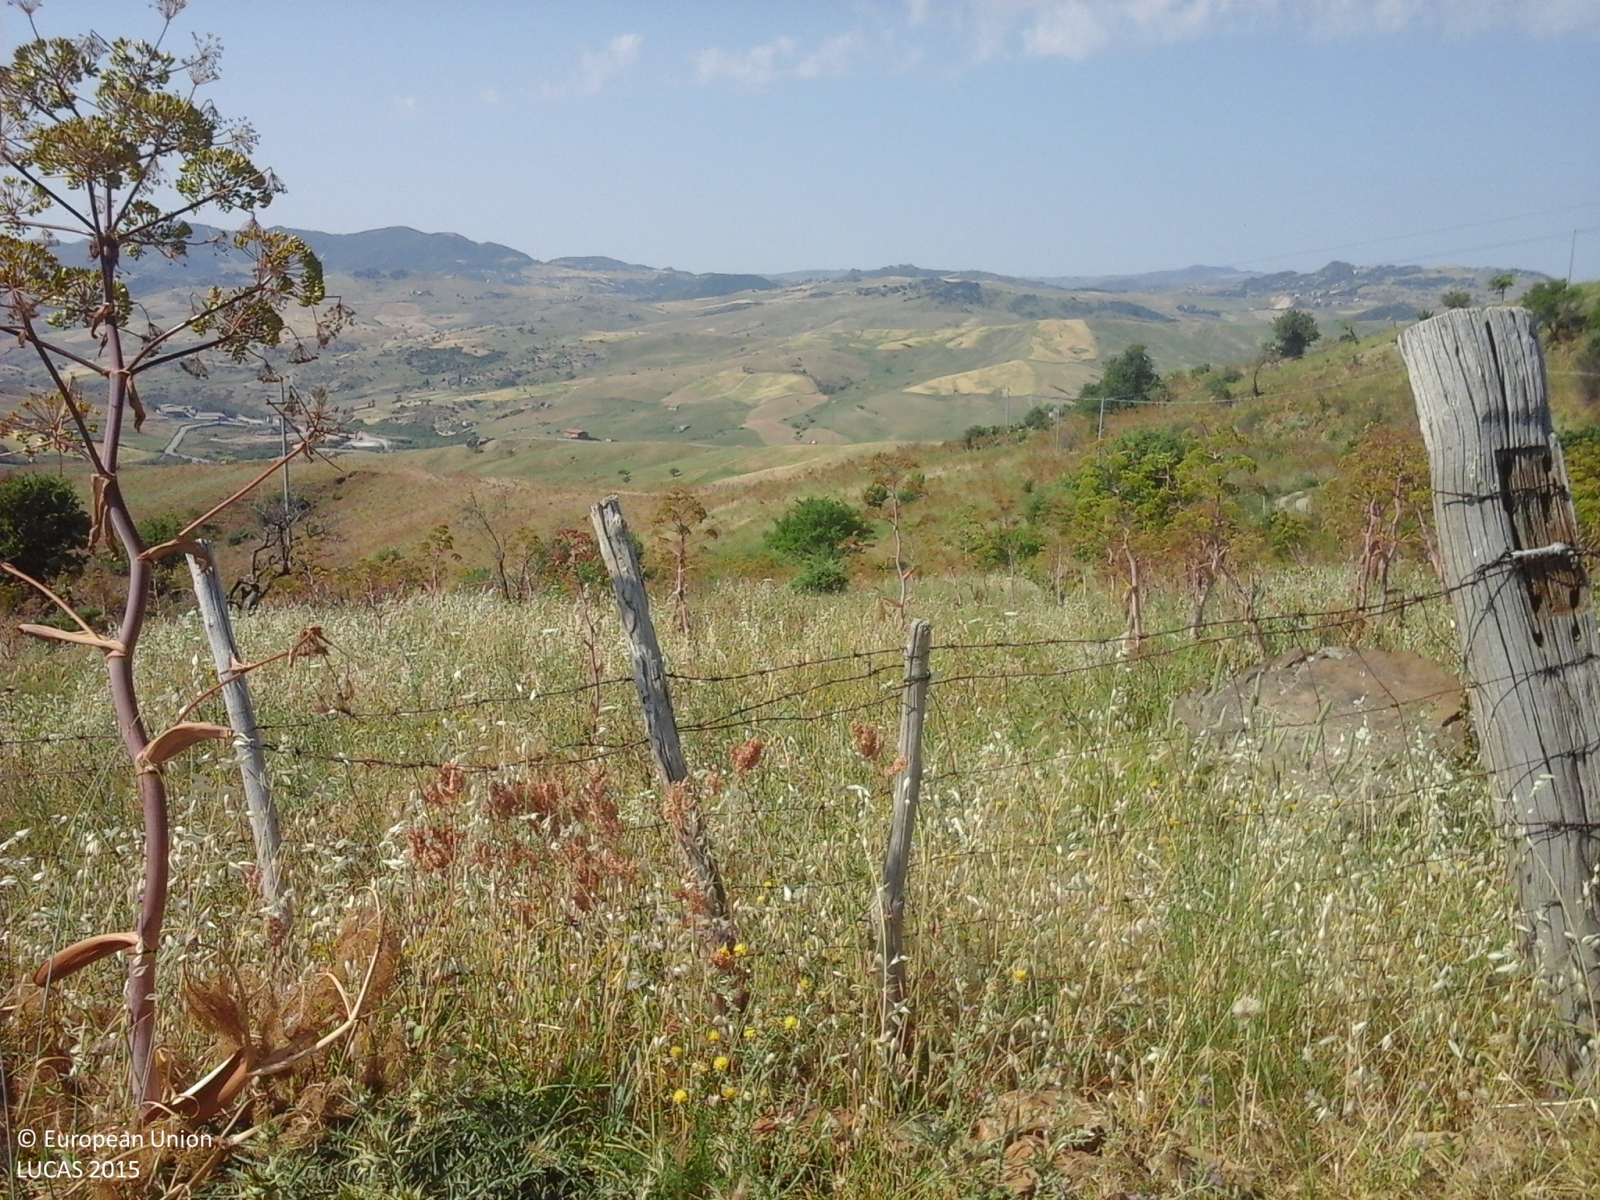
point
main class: Grassland
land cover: Grassland with sparse tree/shrub cover
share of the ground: > 75 %
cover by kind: herbaceous plants 85 %, shrubs 10 %, broadleaved forest trees 5 %
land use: Agriculture (excluding fallow land and kitchen gardens)
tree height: > 5 m
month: June
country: IT
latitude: 37.8238
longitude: 14.4788
